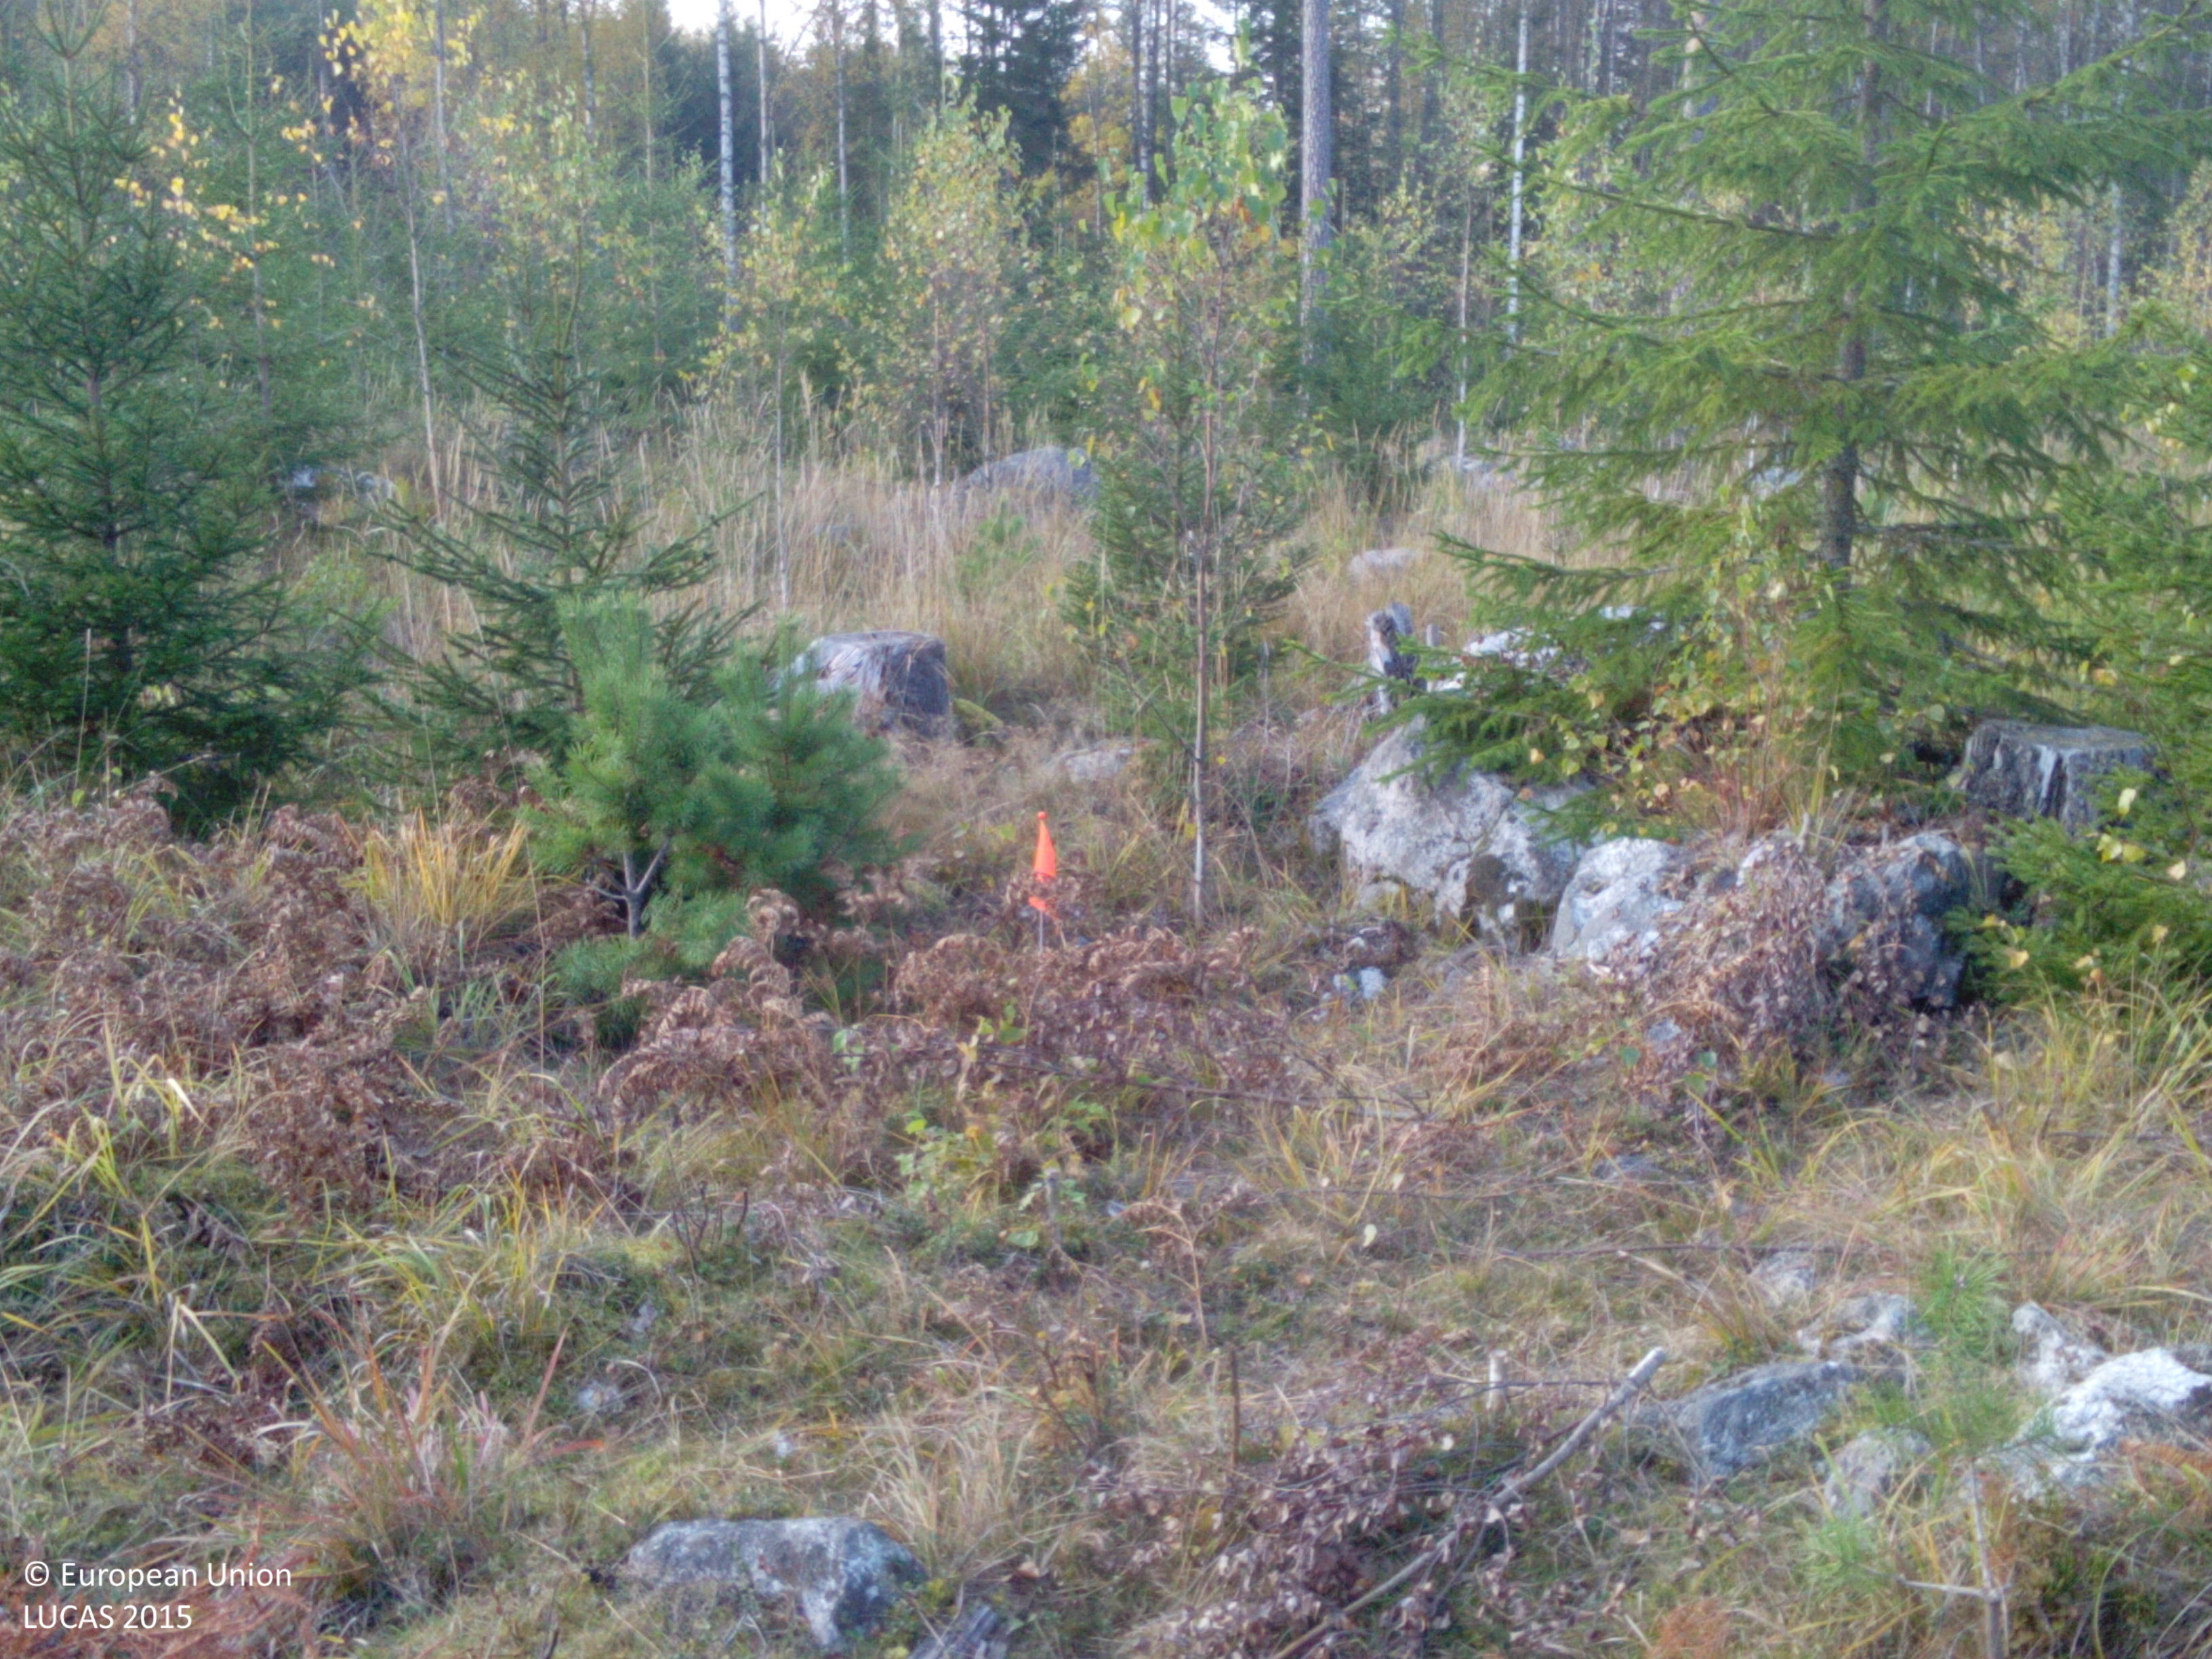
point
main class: Woodland
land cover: Spruce dominated mixed woodland
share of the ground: 50 - 75 %
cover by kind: herbaceous plants 45 %, coniferous forest trees 25 %, broadleaved forest trees 25 %, lichens and mosses 5 %
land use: Forestry
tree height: < 5 m
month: October
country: SE
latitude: 58.8845
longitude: 16.2921
